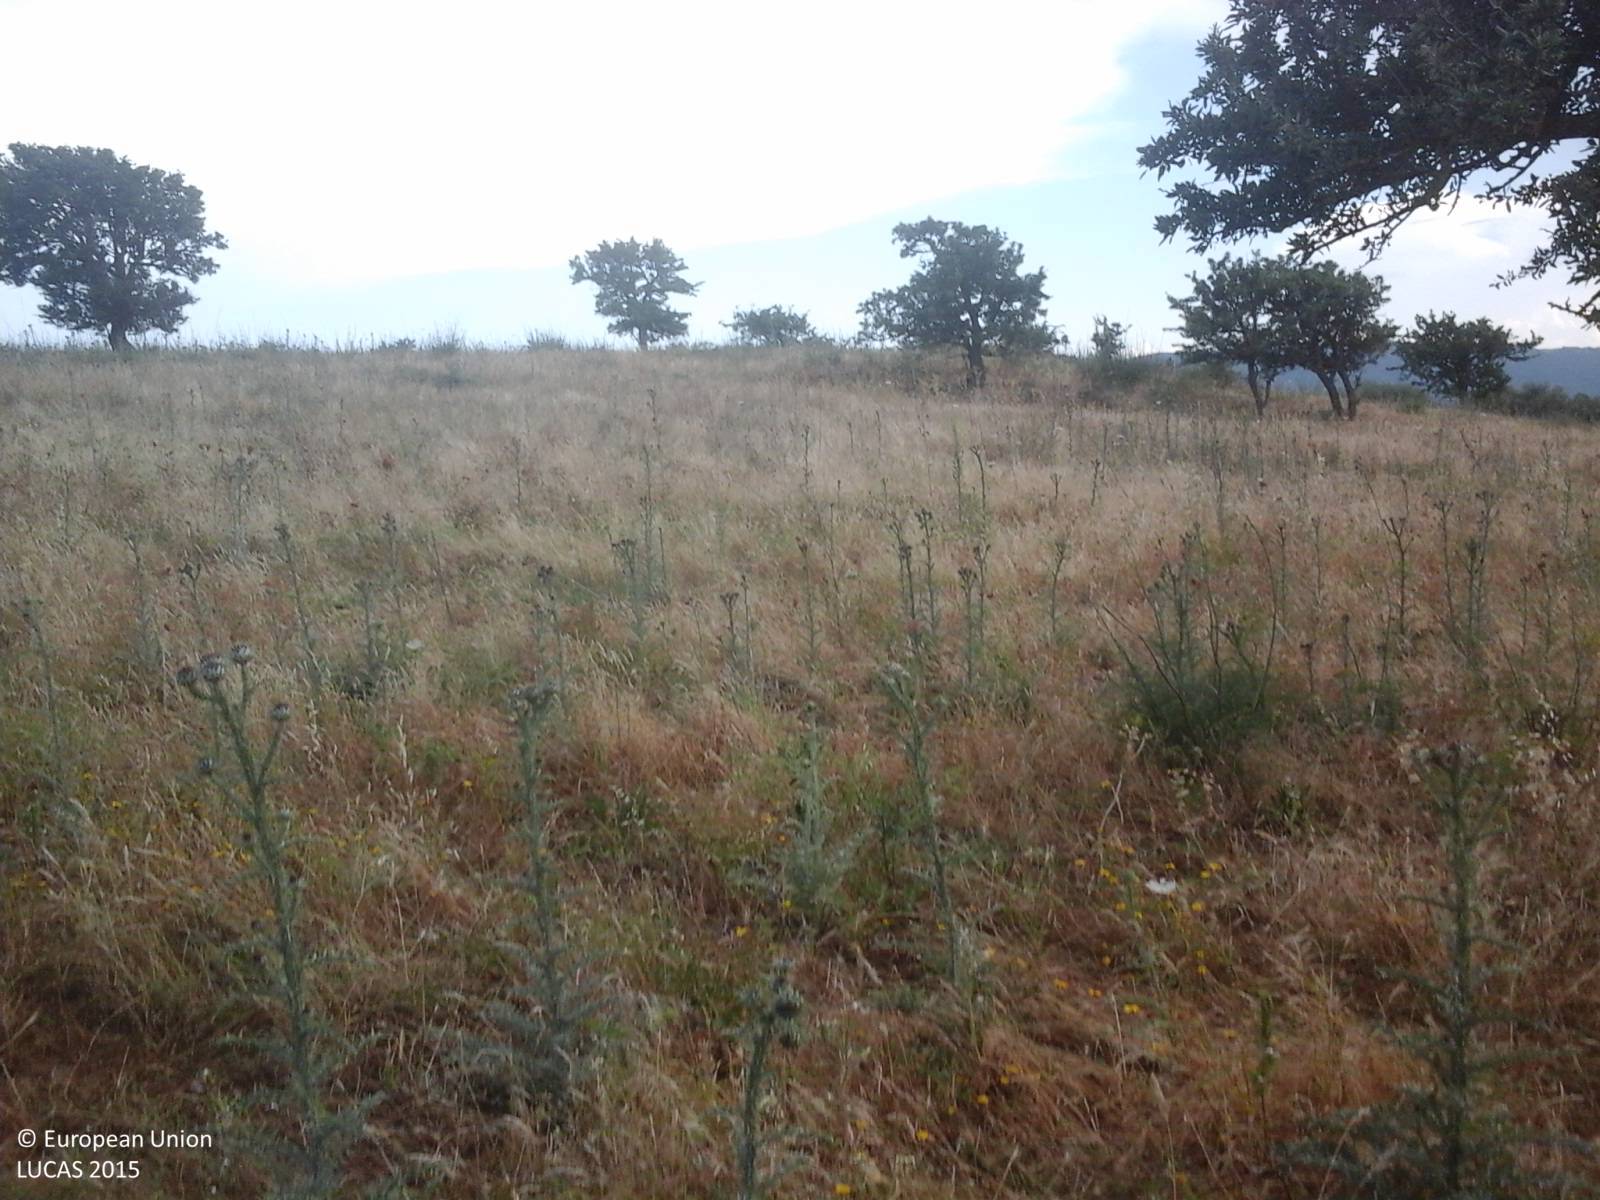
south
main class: Grassland
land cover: Grassland with sparse tree/shrub cover
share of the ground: > 75 %
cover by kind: herbaceous plants 95 %, broadleaved forest trees 5 %
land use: Agriculture (excluding fallow land and kitchen gardens)
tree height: > 5 m
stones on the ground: < 10 %
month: June
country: IT
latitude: 40.5010
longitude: 9.4247
